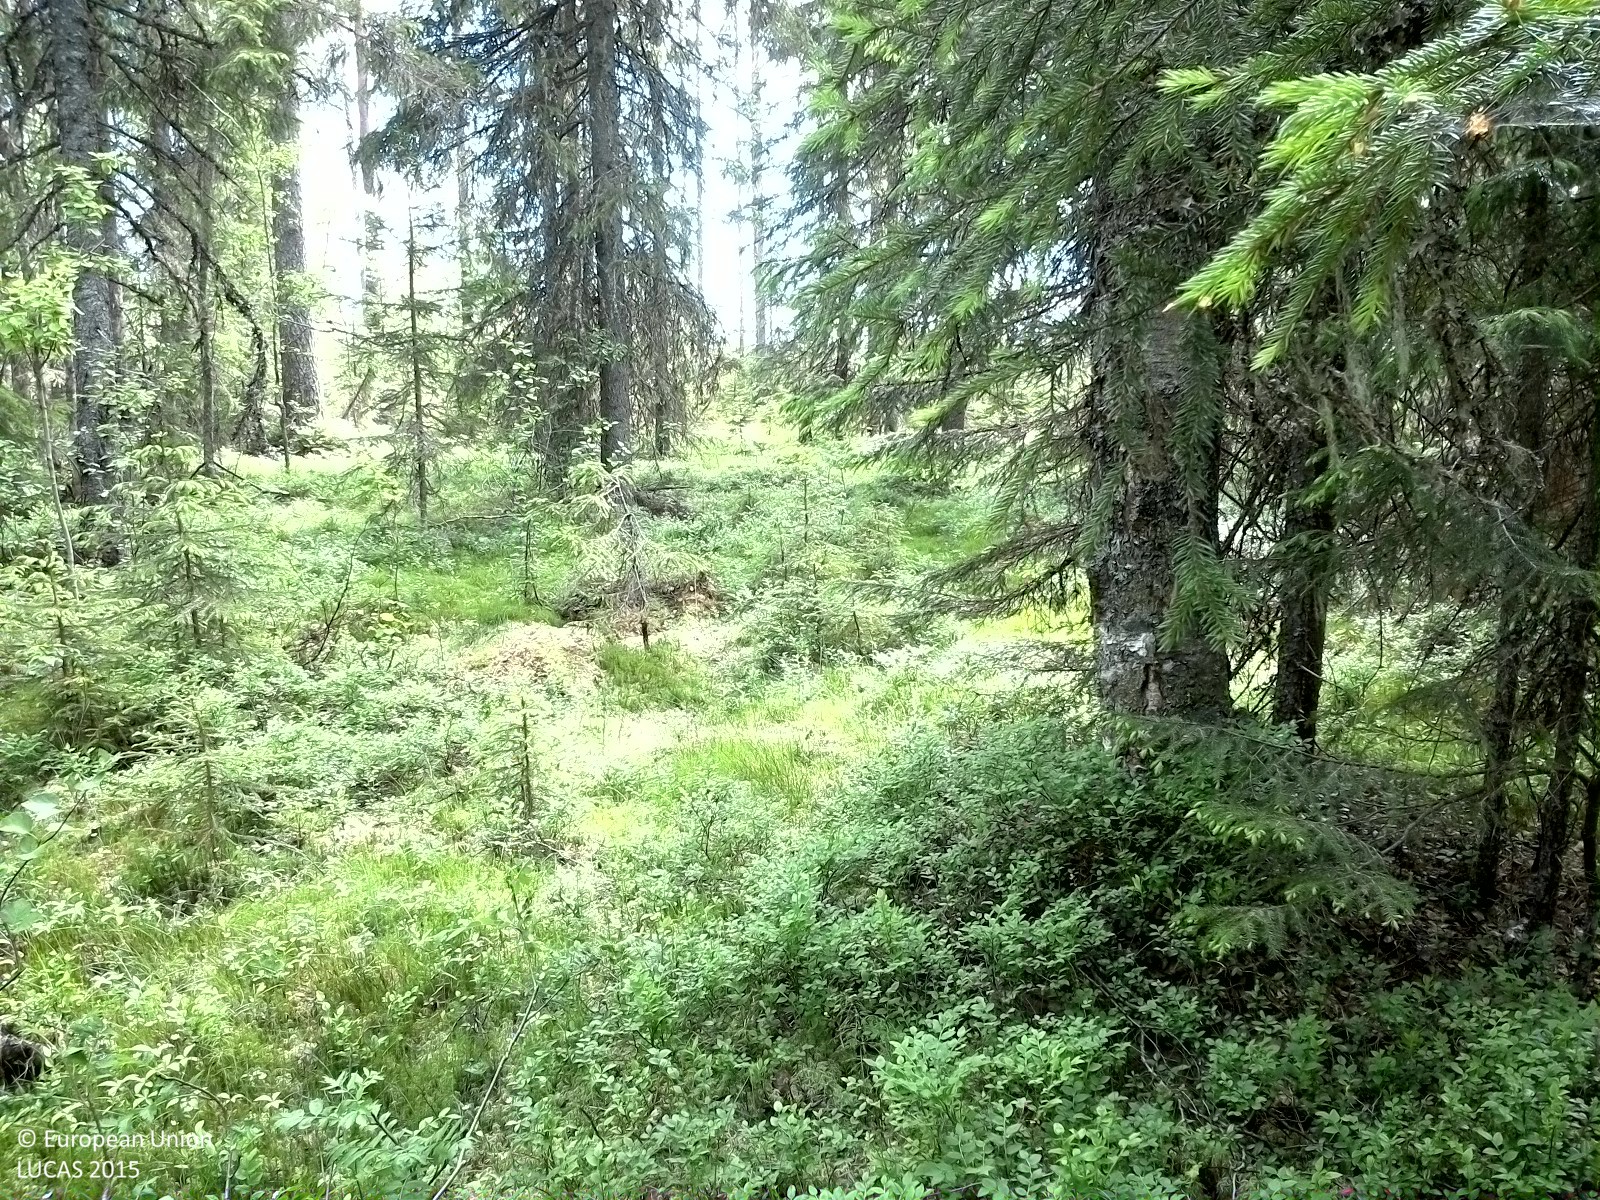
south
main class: Woodland
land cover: Spruce dominated coniferous woodland
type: boreal forest
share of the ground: 25 - 50 %
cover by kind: coniferous forest trees 40 %, lichens and mosses 30 %, shrubs 25 %, broadleaved forest trees 5 %
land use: Forestry
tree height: > 5 m
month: July
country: SE
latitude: 62.1495
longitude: 16.8313
